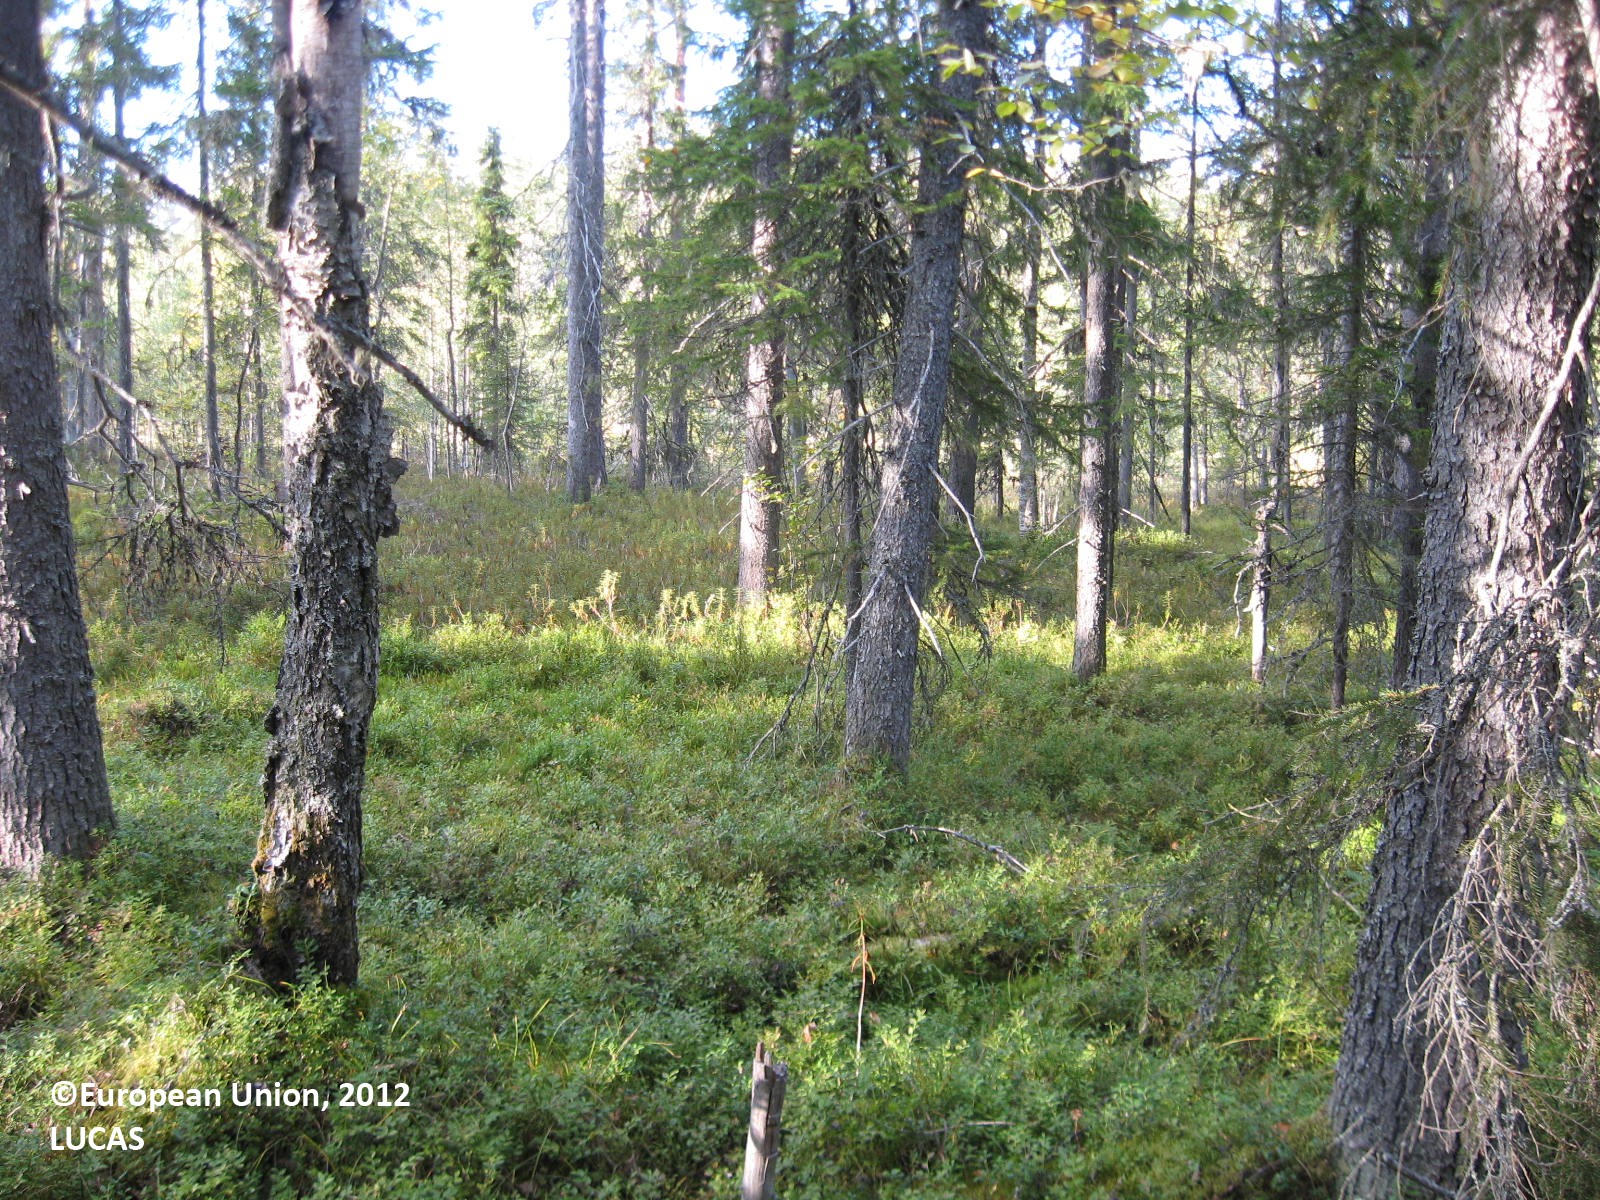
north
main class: Woodland
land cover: Spruce dominated coniferous woodland
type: boreal forest
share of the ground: > 75 %
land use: Forestry
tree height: > 5 m
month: August
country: FI
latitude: 63.9083
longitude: 29.8616
